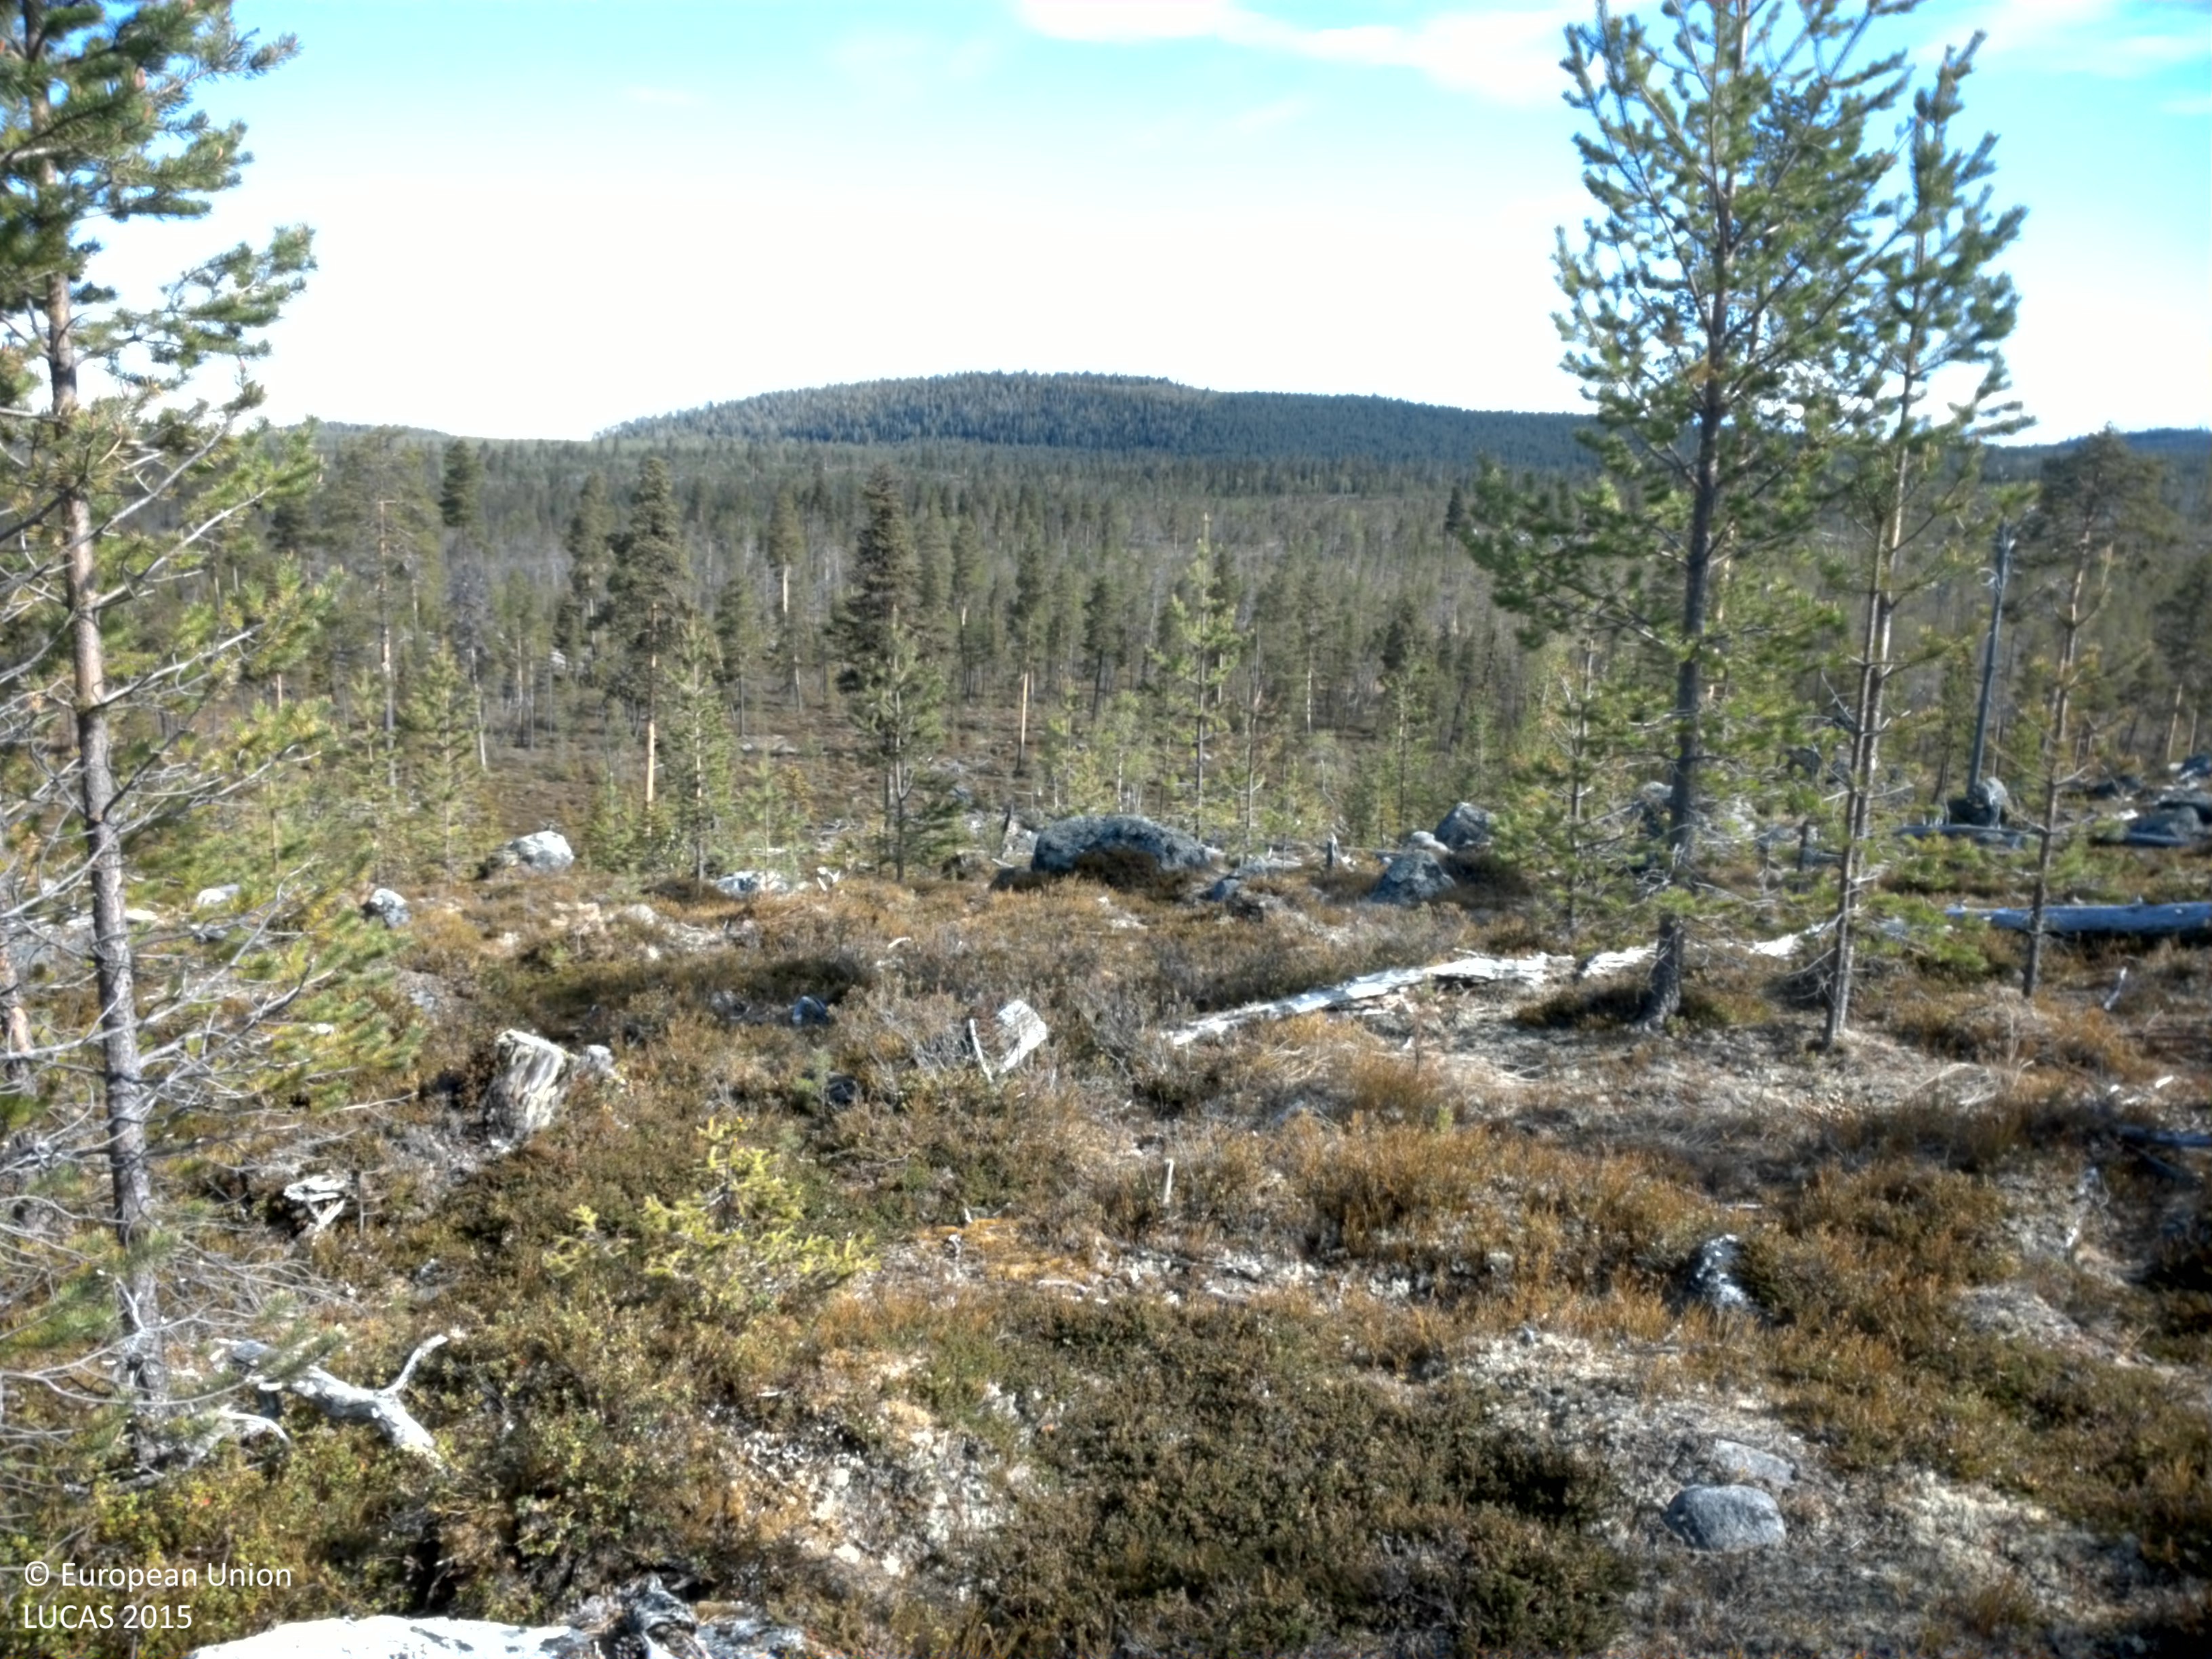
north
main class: Woodland
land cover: Pine dominated coniferous woodland
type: boreal forest
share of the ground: 10 - 25 %
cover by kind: shrubs 55 %, coniferous forest trees 20 %, consolidated bare surface 15 %, lichens and mosses 10 %
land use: Forestry
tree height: < 5 m
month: June
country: SE
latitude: 65.9413
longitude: 18.7276
